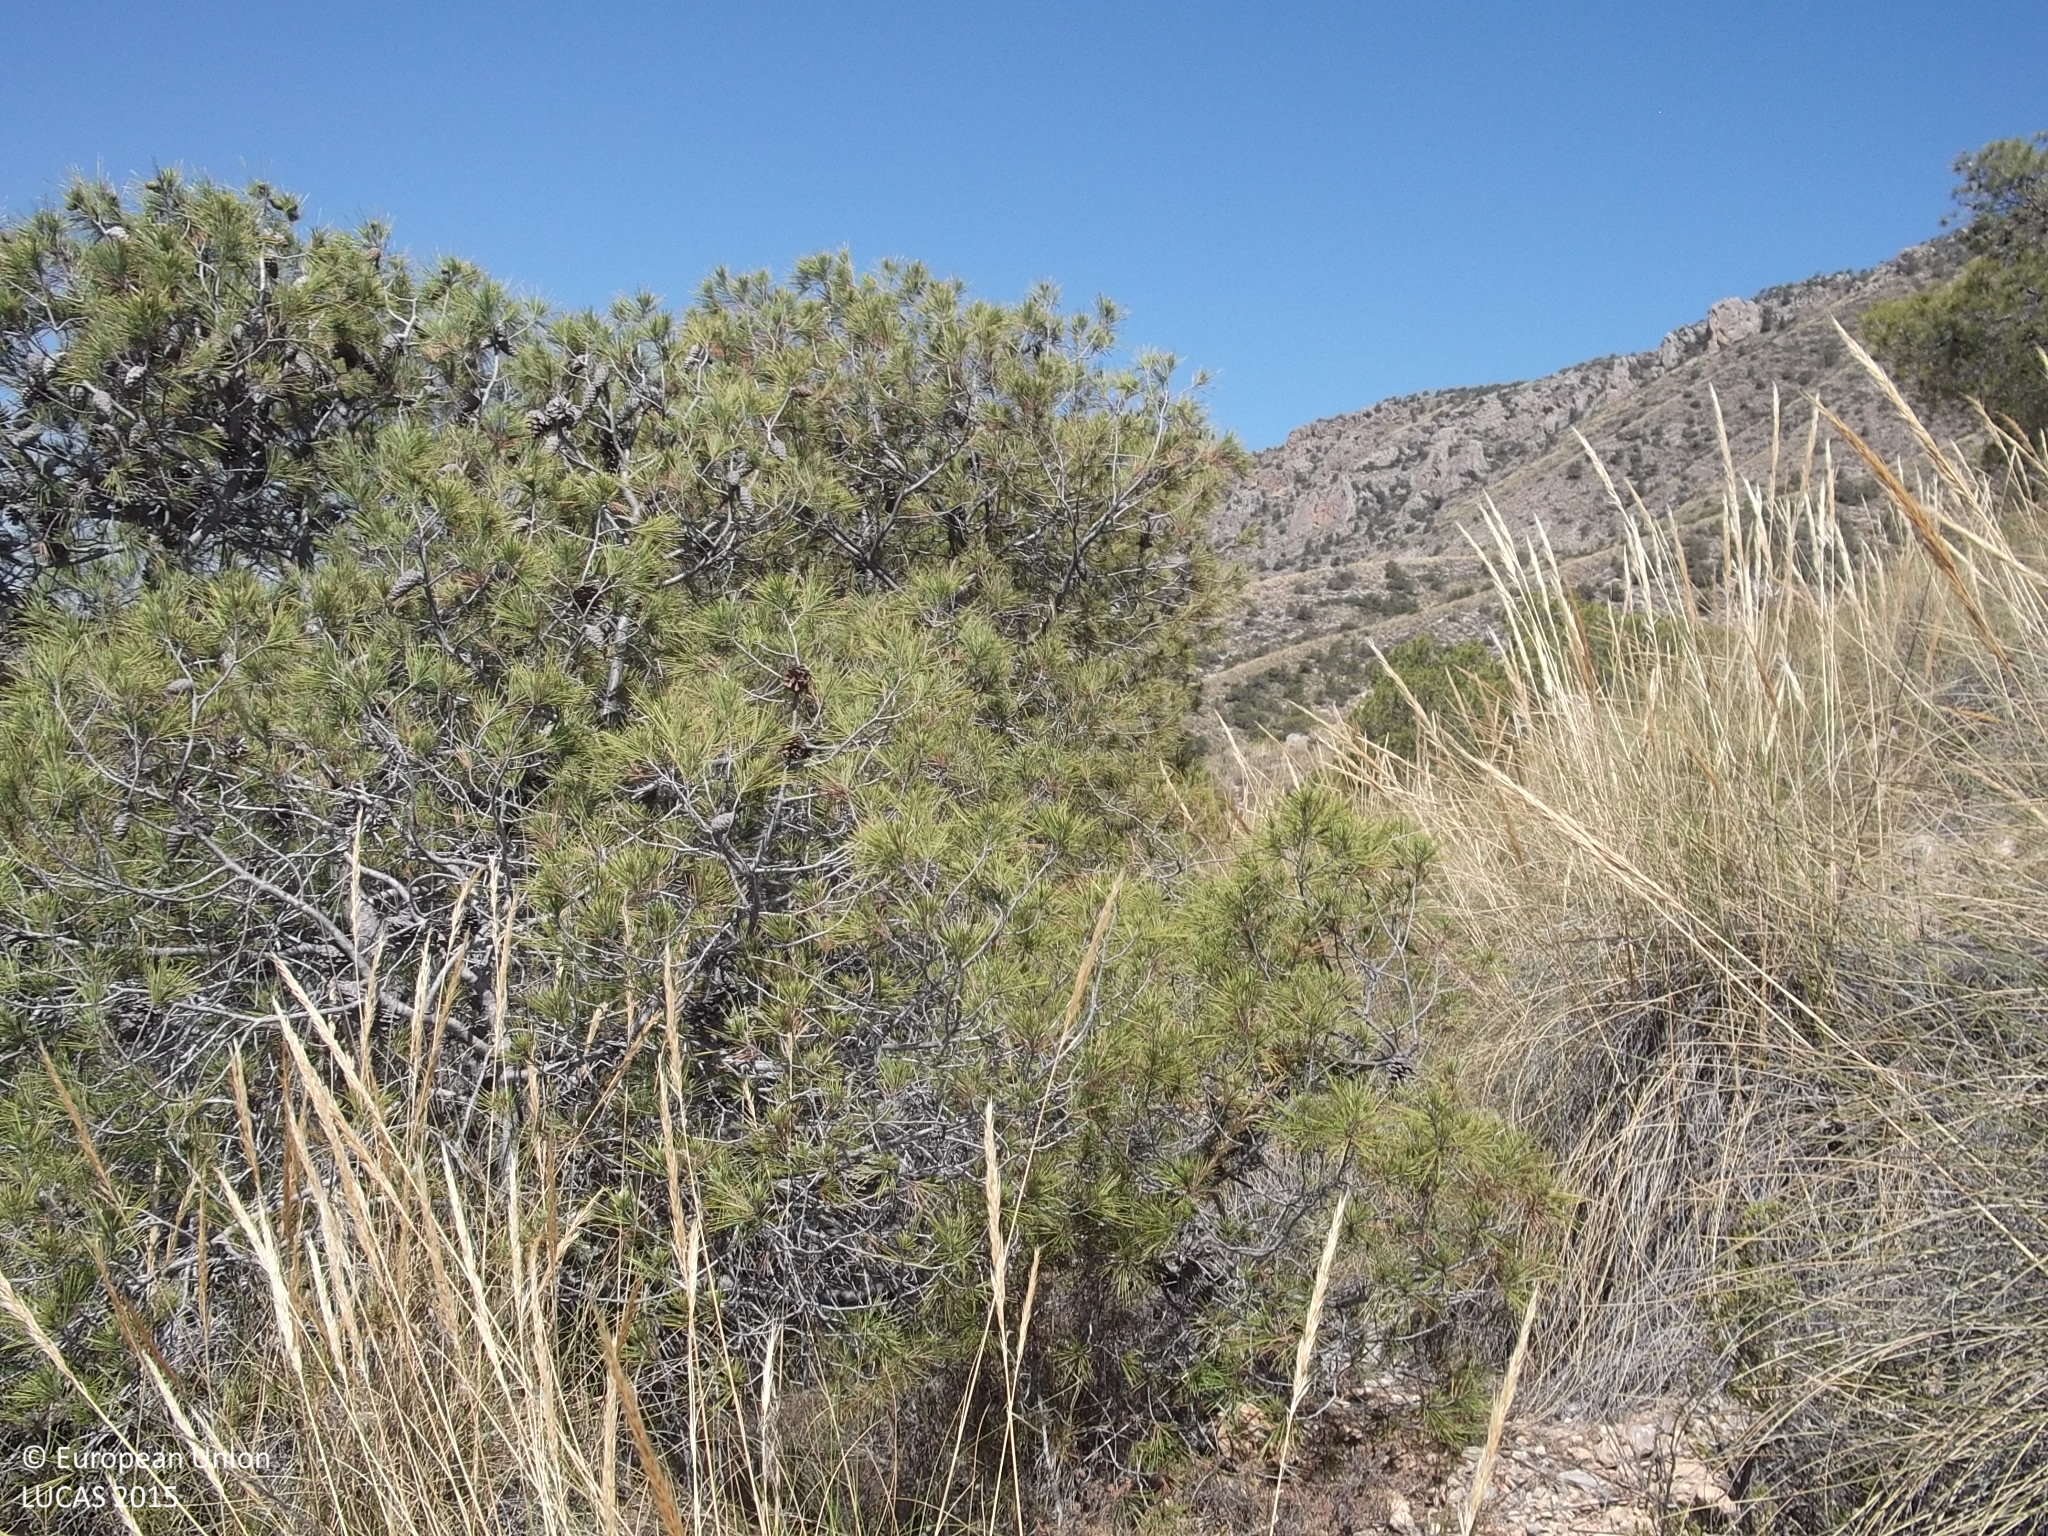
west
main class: Woodland
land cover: Pine dominated coniferous woodland
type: coniferous forest of the mediterranean region
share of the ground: 10 - 25 %
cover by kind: shrubs 30 %, herbaceous plants 30 %, coniferous forest trees 20 %, consolidated bare surface 20 %
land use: Forestry
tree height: < 5 m
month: June
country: ES
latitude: 38.1863
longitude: -1.4620
